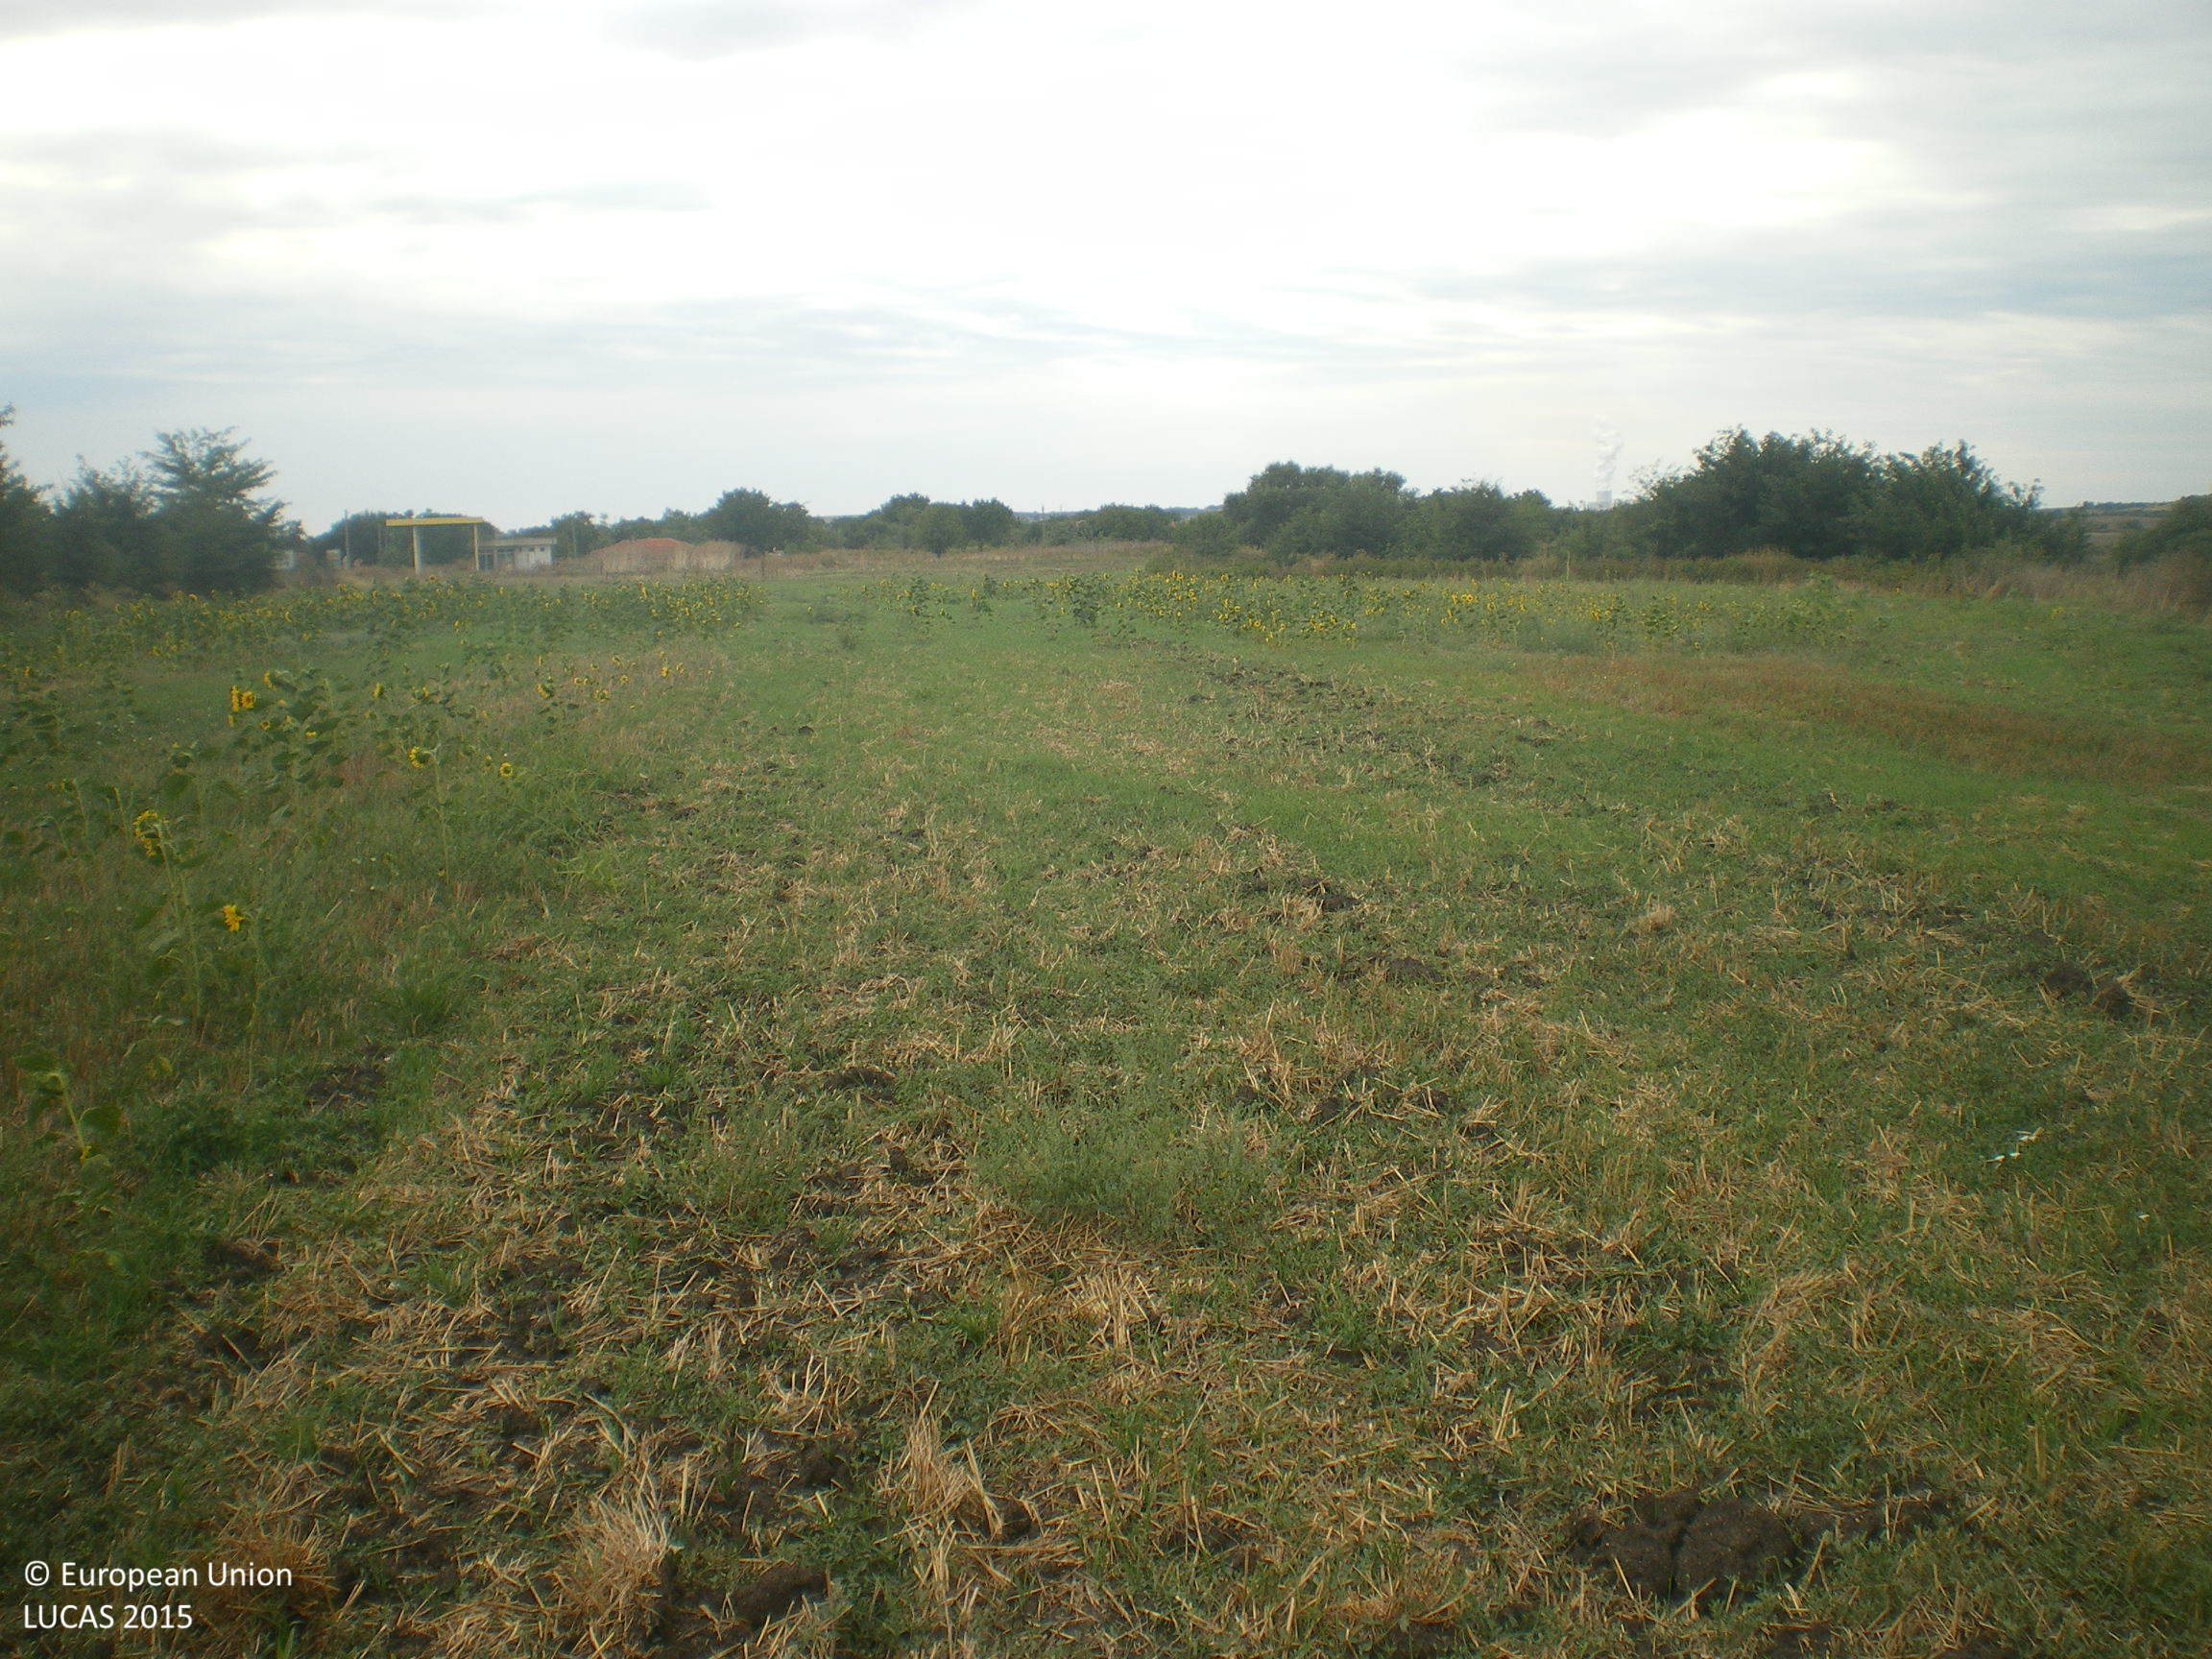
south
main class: Cropland
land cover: Common wheat
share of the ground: < 10 %
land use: Agriculture (excluding fallow land and kitchen gardens)
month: September
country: BG
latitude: 42.2456
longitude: 25.9408
